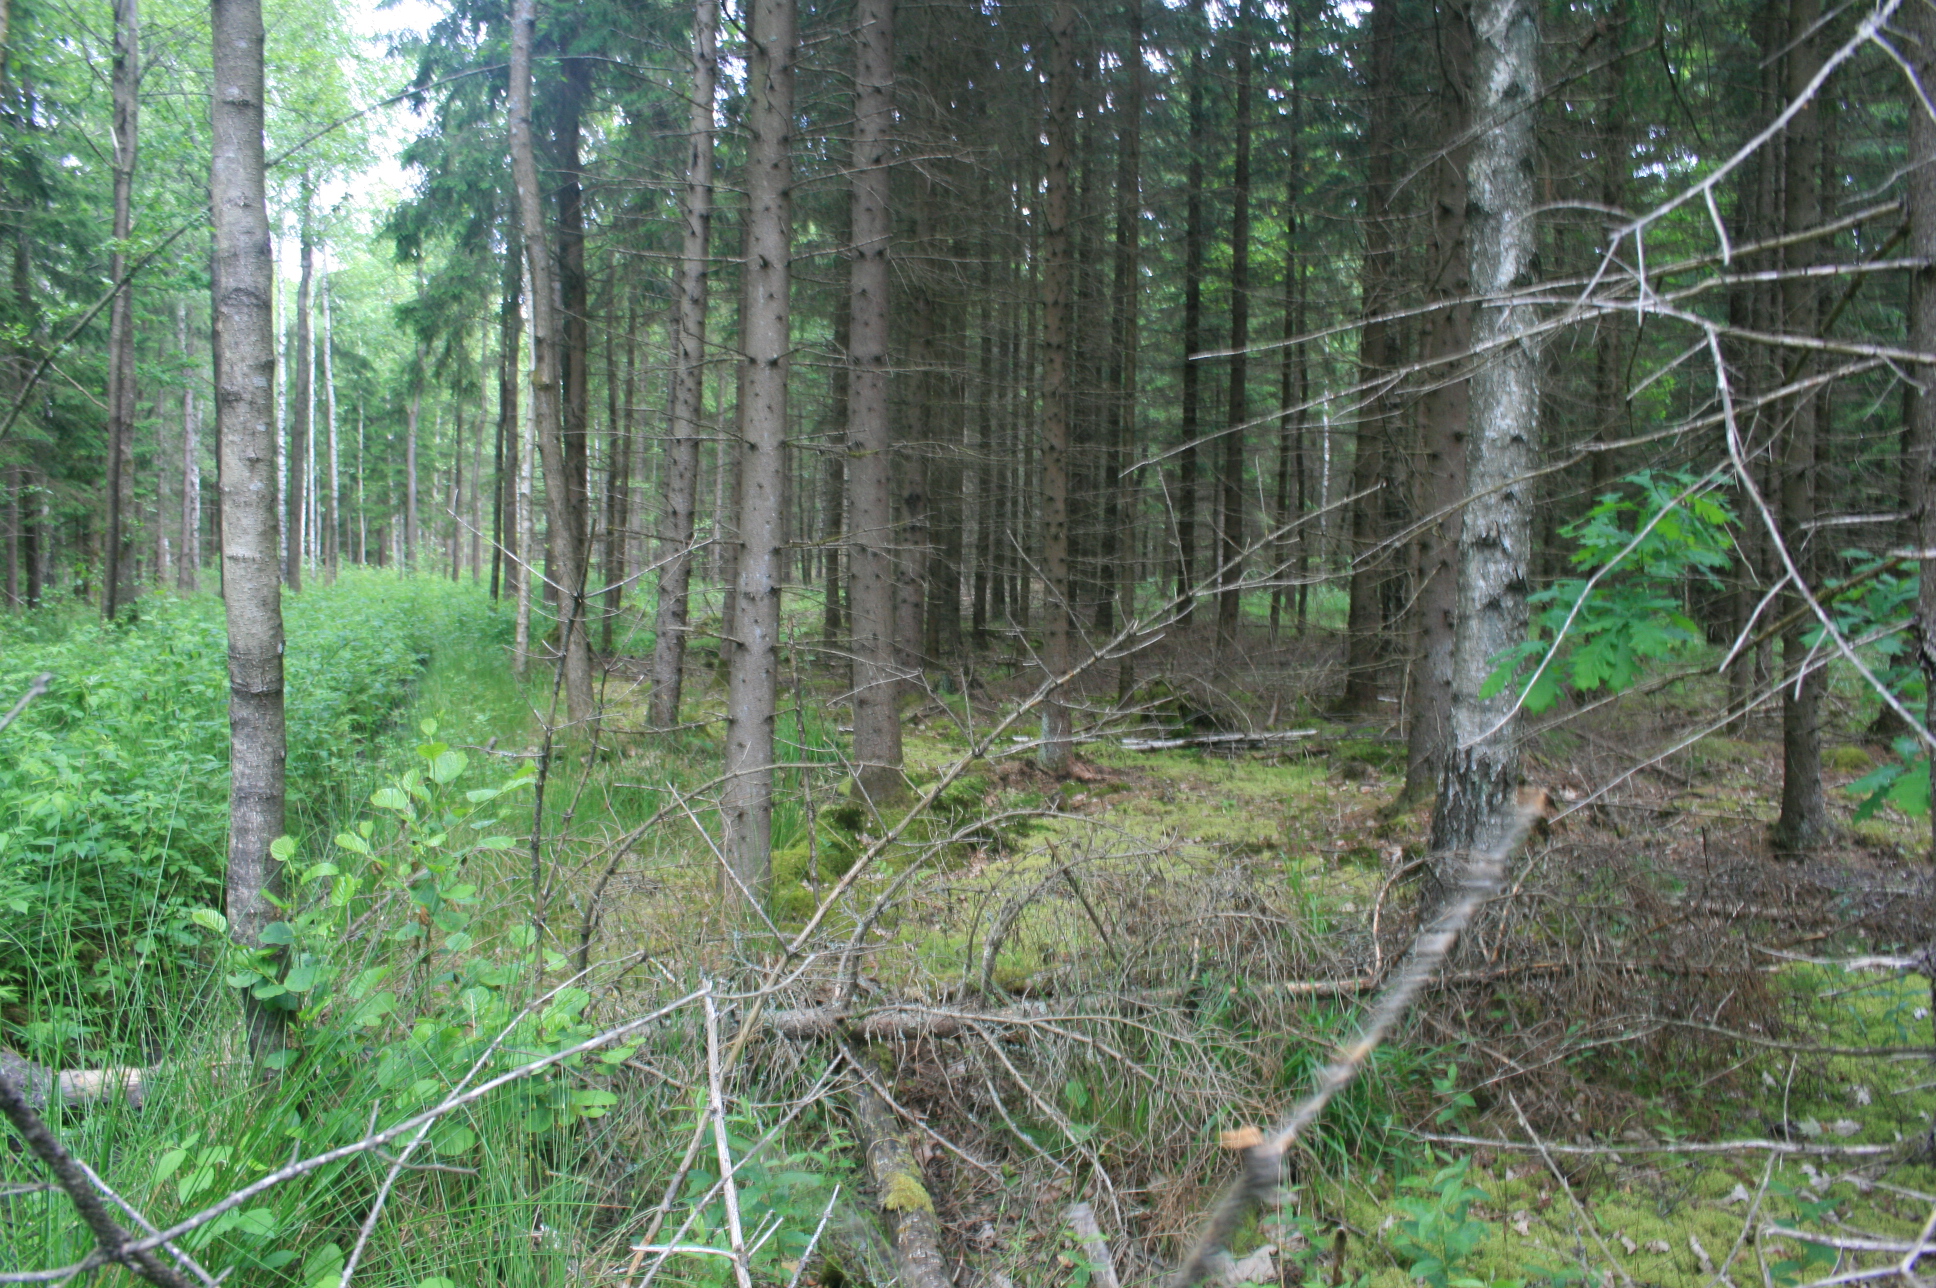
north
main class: Woodland
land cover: Spruce dominated mixed woodland
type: hemiboreal forest and nemoral coniferous forest and mixed broadleaved-coniferous forest
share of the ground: > 75 %
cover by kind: coniferous forest trees 65 %, broadleaved forest trees 30 %, herbaceous plants 5 %
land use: Forestry
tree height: > 5 m
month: June
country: LT
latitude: 55.3203
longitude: 22.1109
